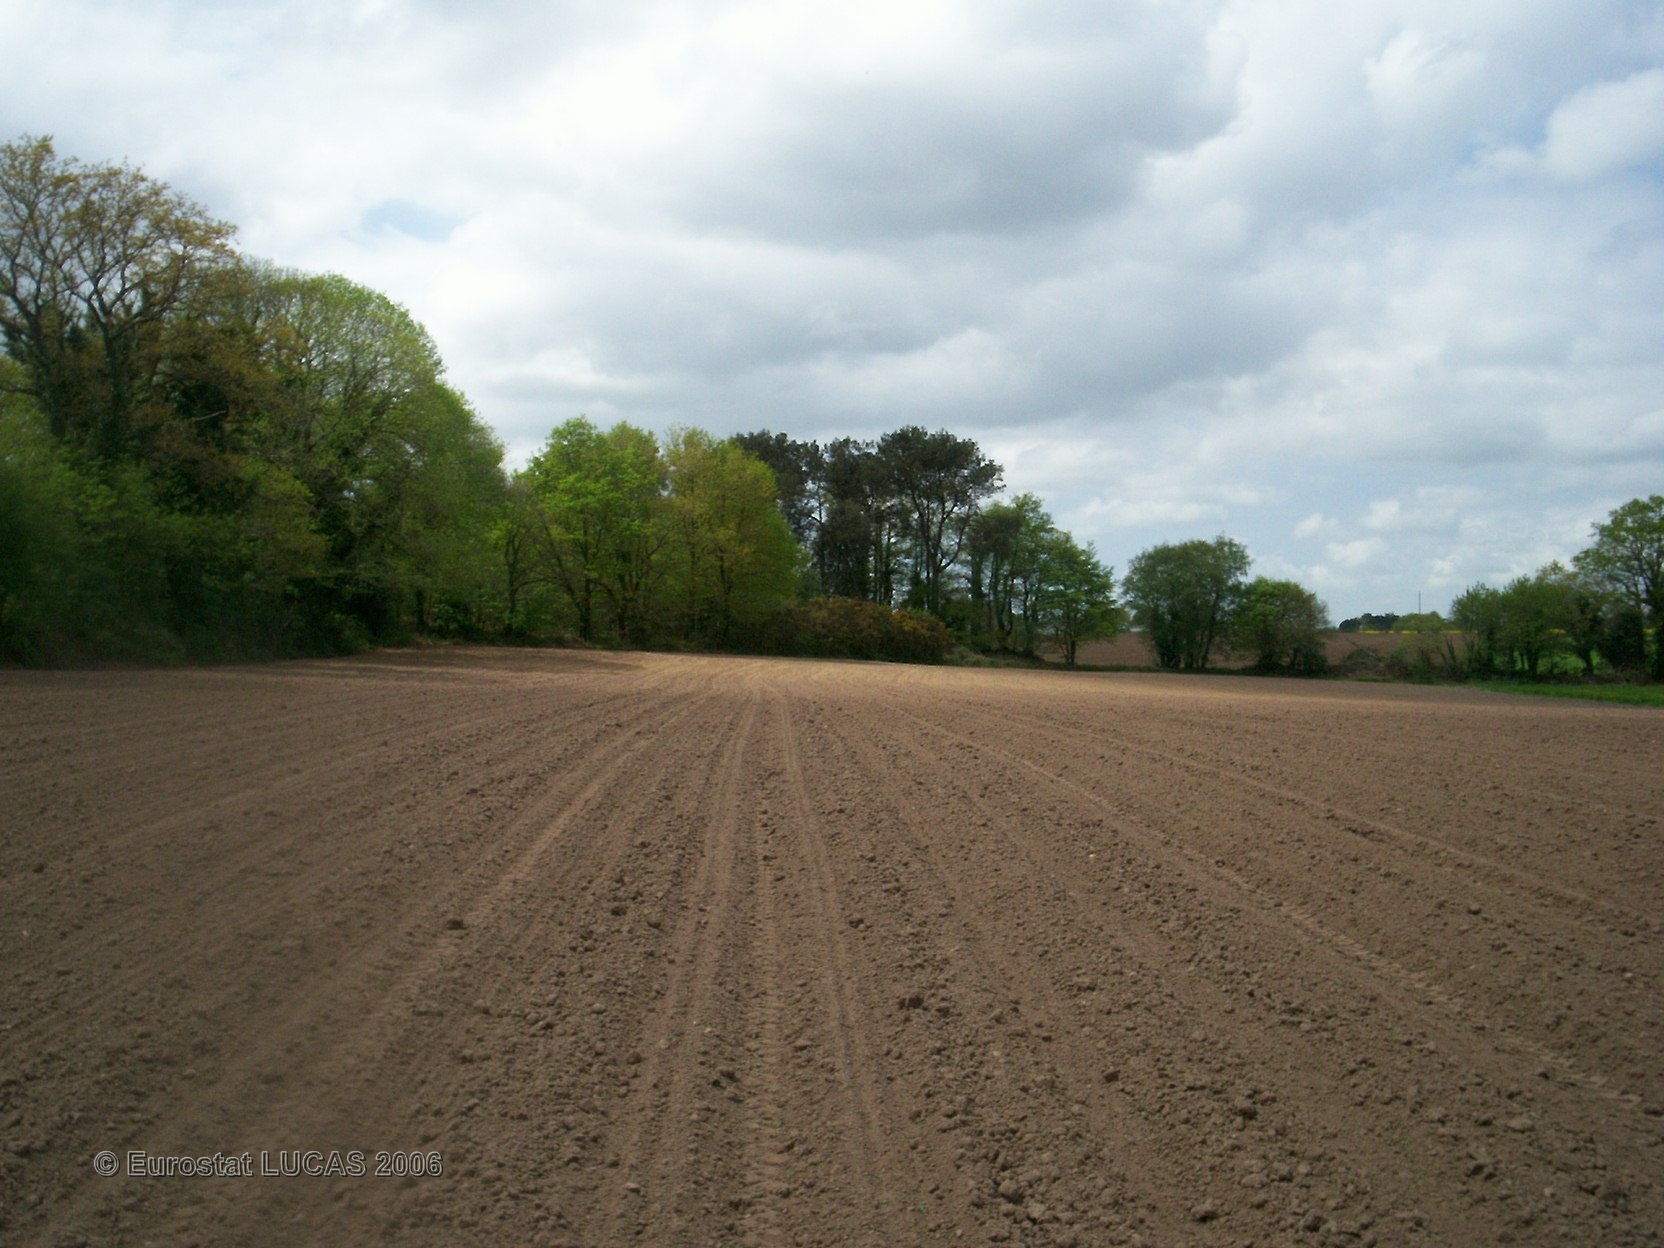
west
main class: Cropland
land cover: Maize
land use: Agriculture (excluding fallow land and kitchen gardens)
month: May
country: FR
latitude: 47.7230
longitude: -2.8487
